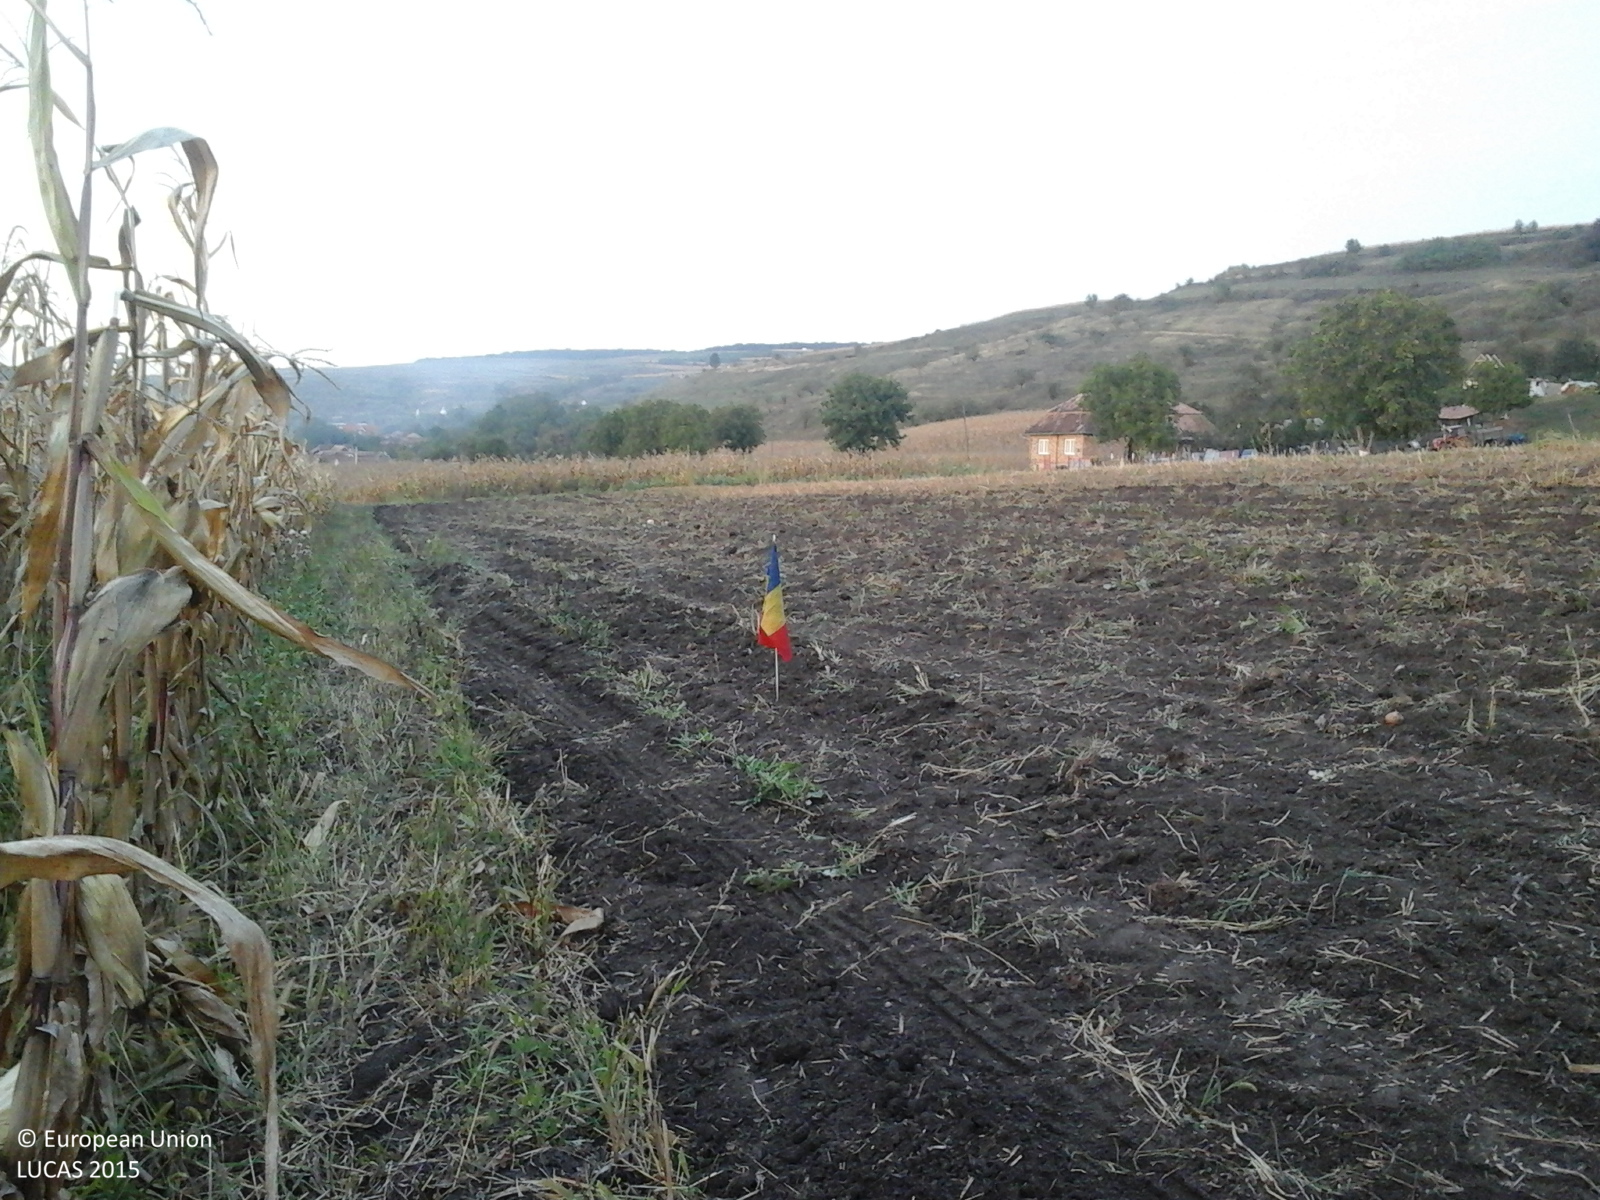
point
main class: Cropland
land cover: Potatoes
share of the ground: < 10 %
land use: Agriculture (excluding fallow land and kitchen gardens)
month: September
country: RO
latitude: 46.5758
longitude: 24.0000
